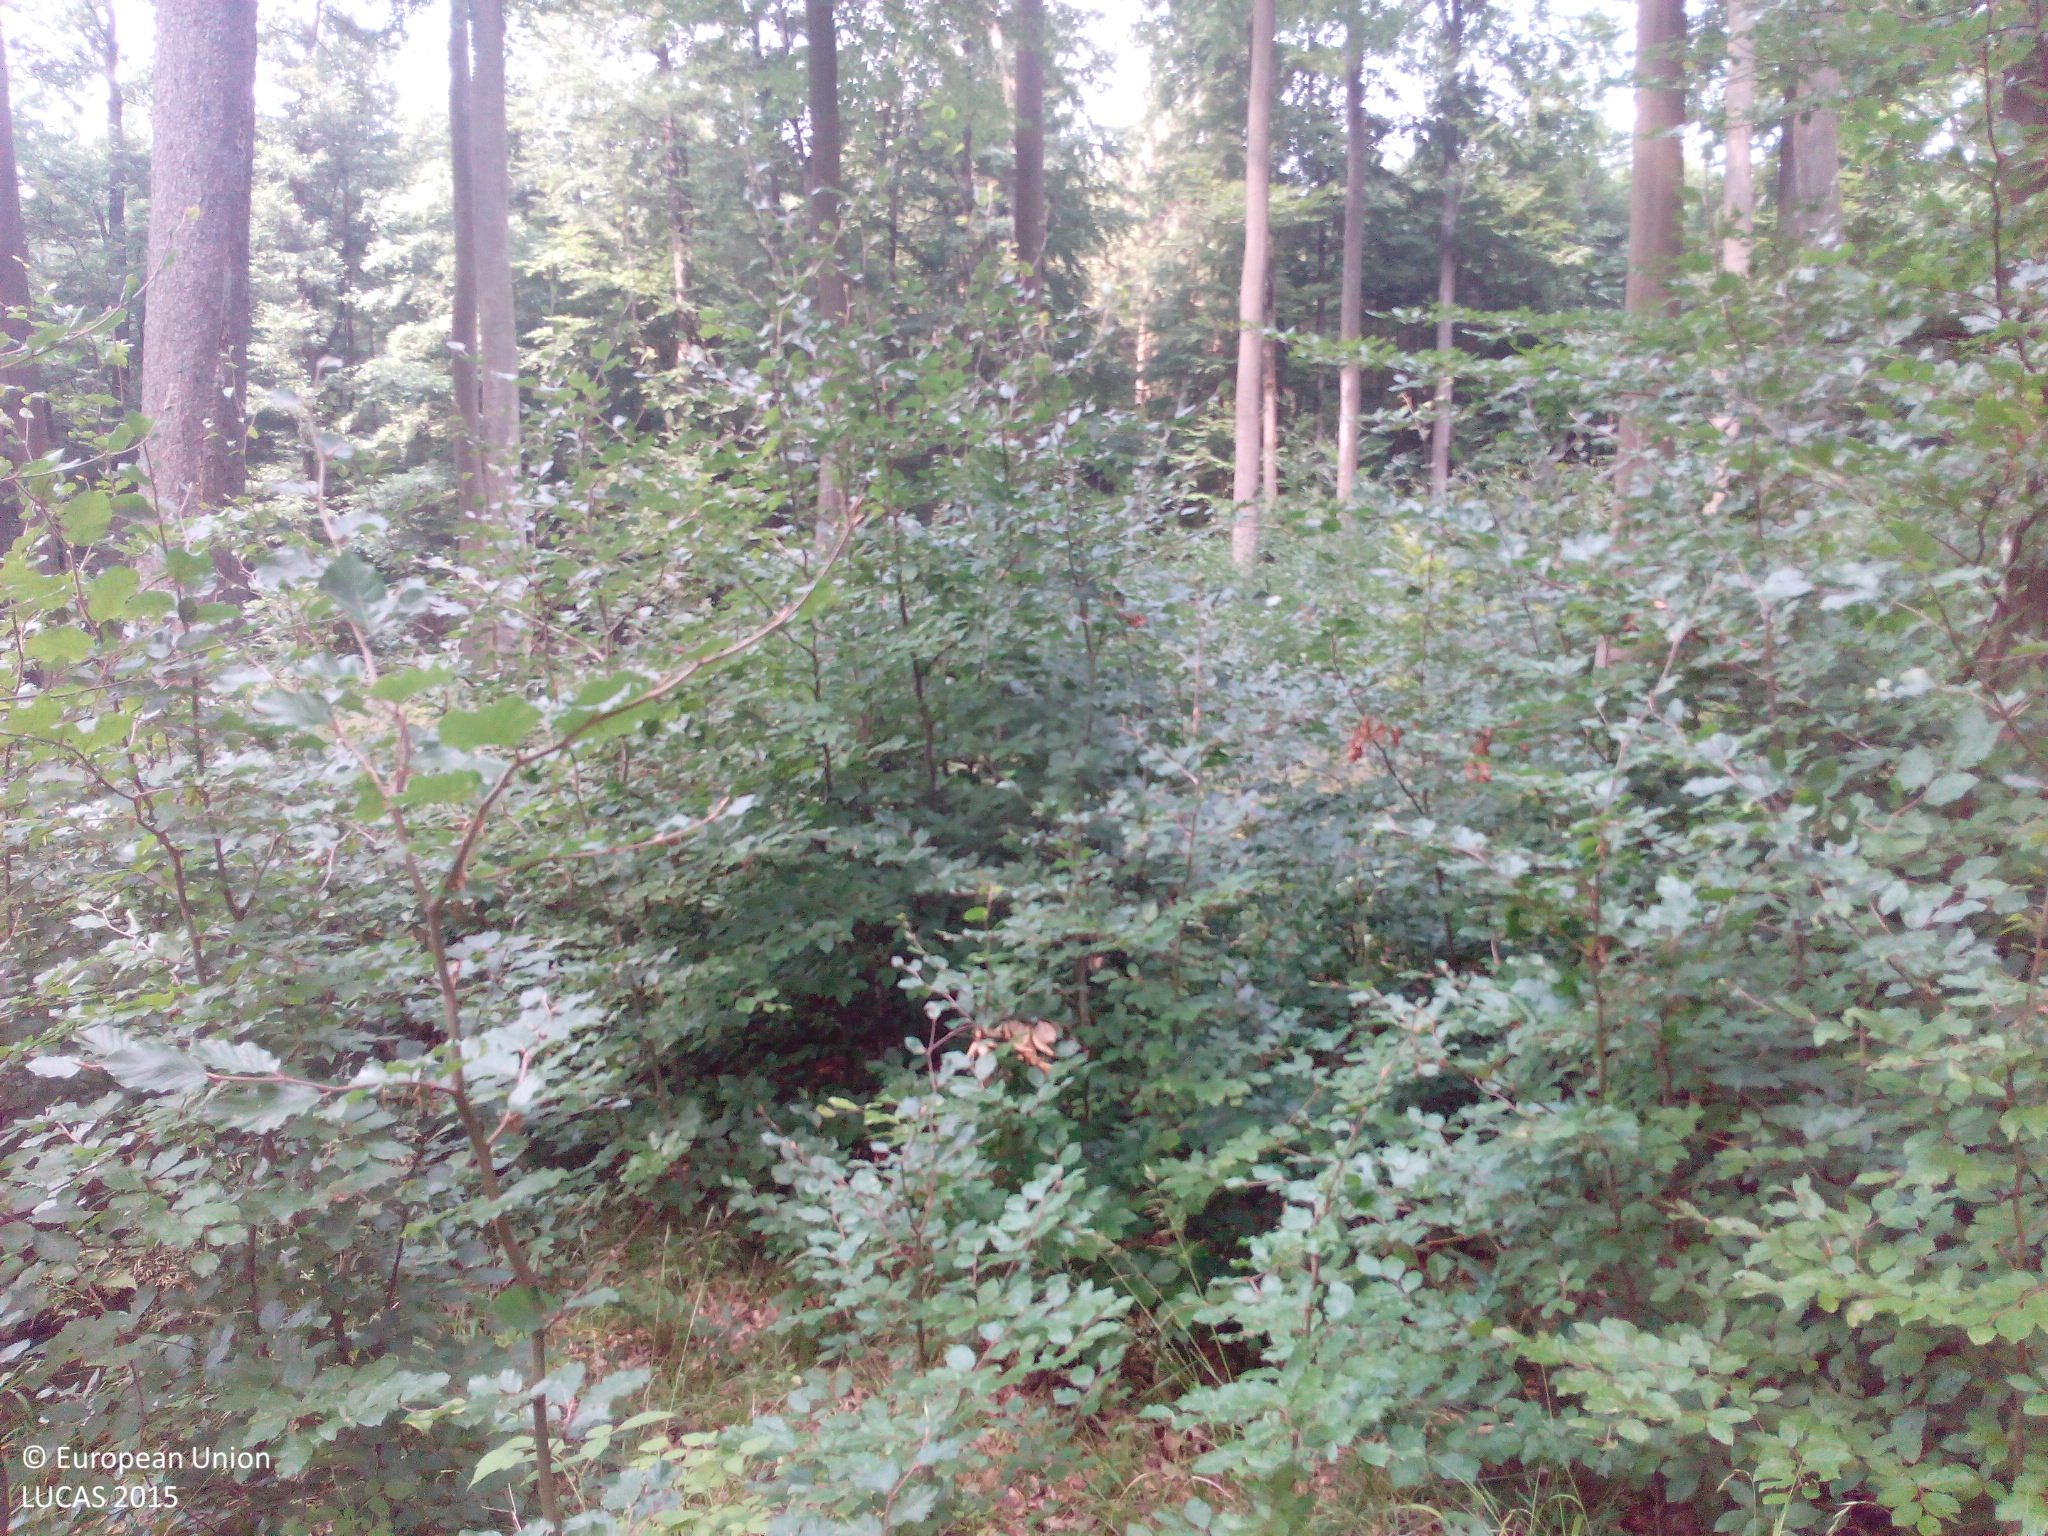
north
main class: Woodland
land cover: Broadleaved woodland
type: beech forest
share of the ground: > 75 %
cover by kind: broadleaved forest trees 70 %, coniferous forest trees 10 %, shrubs 10 %, herbaceous plants 10 %
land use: Forestry
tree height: > 5 m
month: August
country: DE
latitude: 50.2764
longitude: 8.1061
